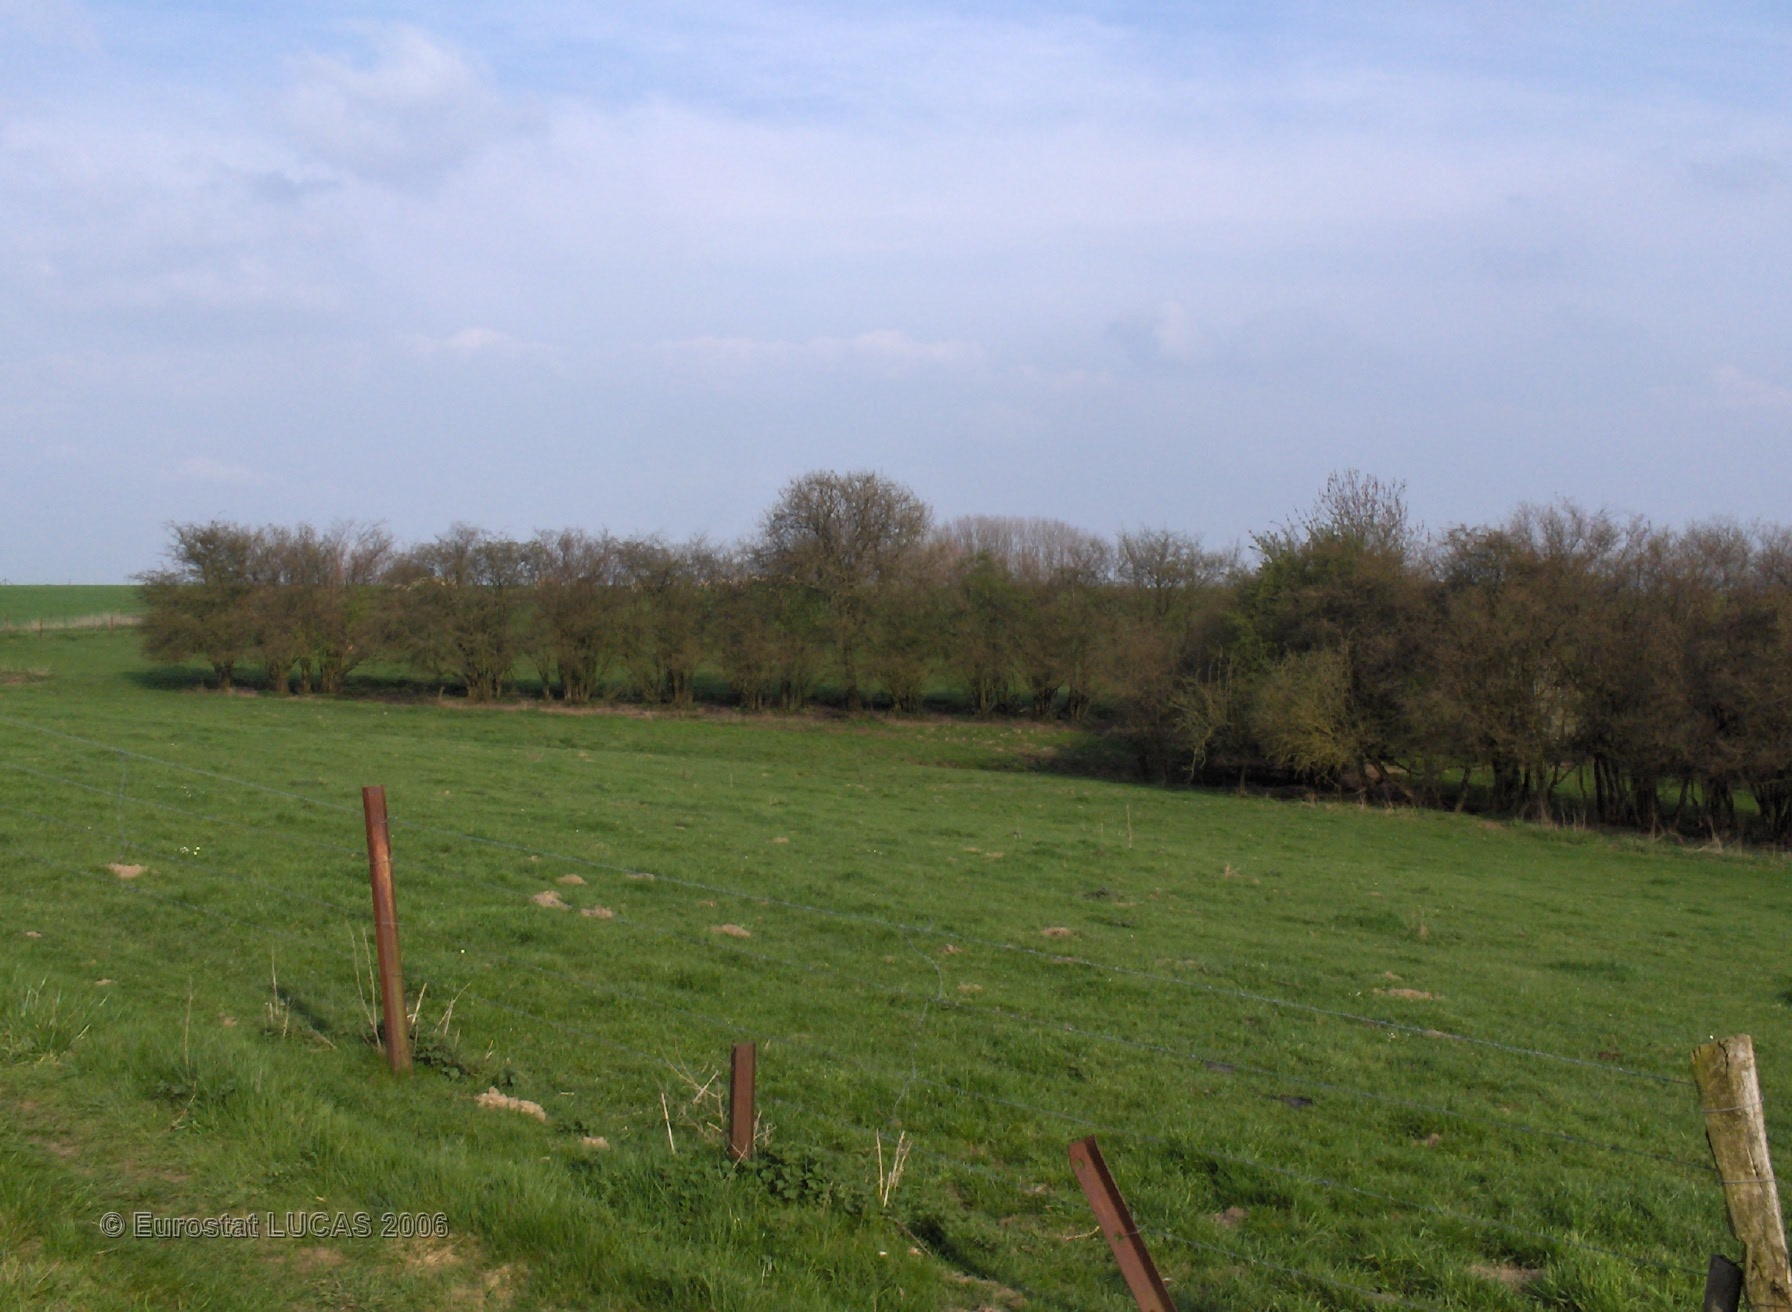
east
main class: Grassland
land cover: Grassland without tree/shrub cover
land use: Agriculture (excluding fallow land and kitchen gardens)
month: April
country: BE
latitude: 50.2531
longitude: 4.5684
